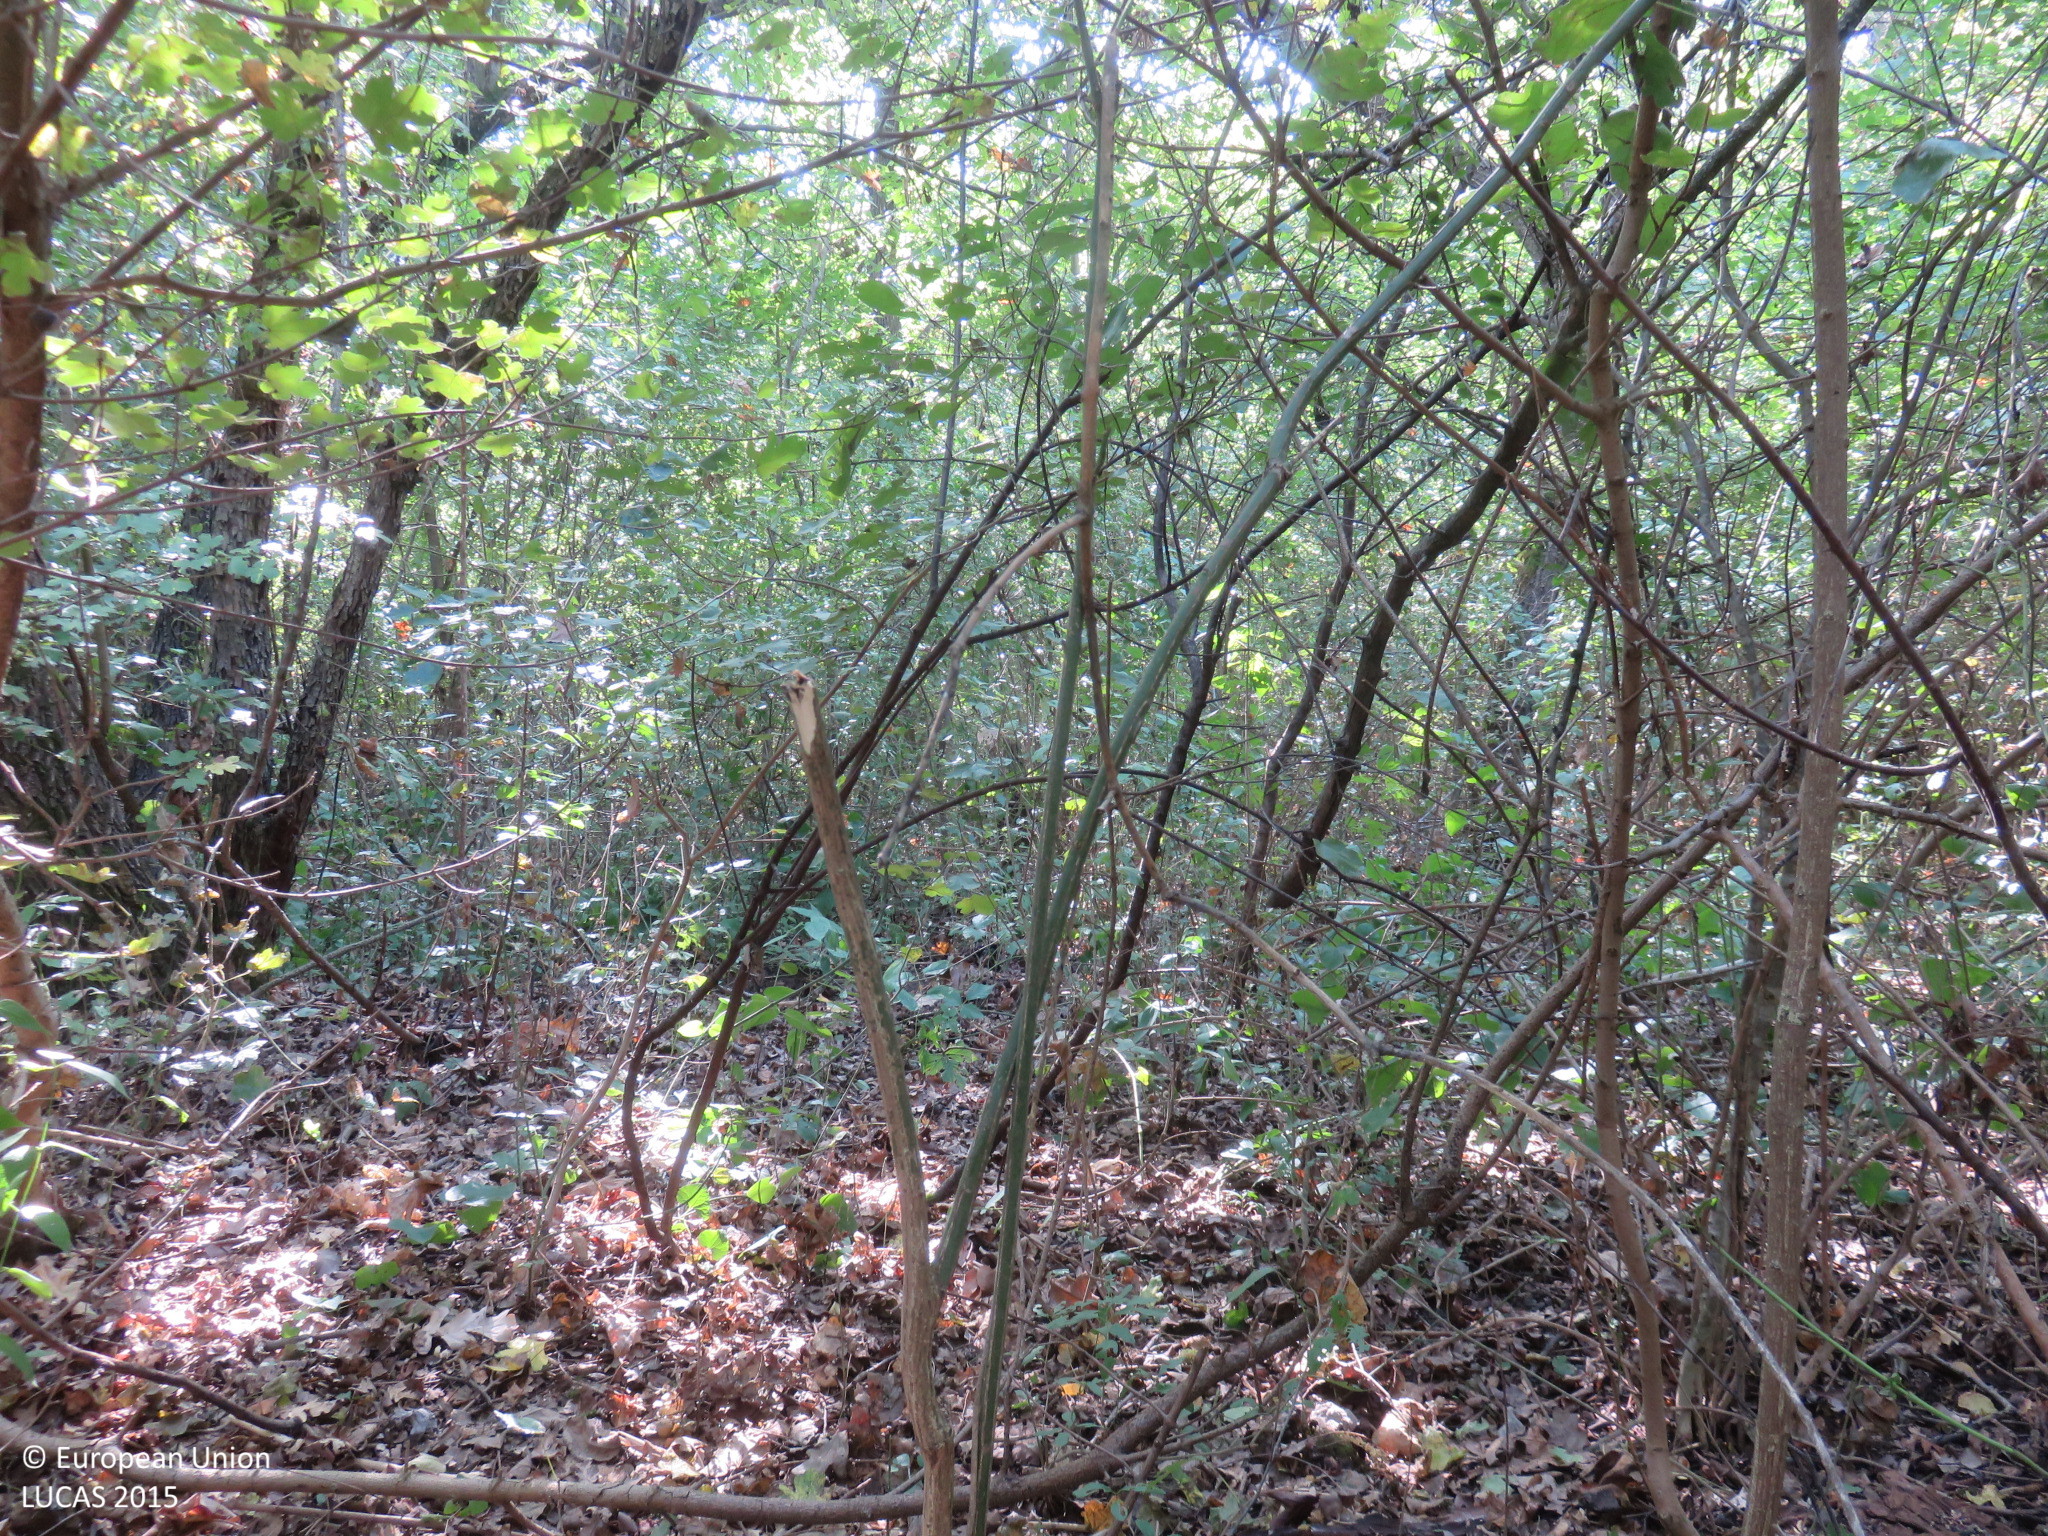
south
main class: Woodland
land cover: Broadleaved woodland
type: mesophytic deciduous forest
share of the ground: > 75 %
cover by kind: broadleaved forest trees 95 %, shrubs 5 %
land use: Forestry
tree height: < 5 m
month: September
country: BG
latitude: 43.4952
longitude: 24.9722
